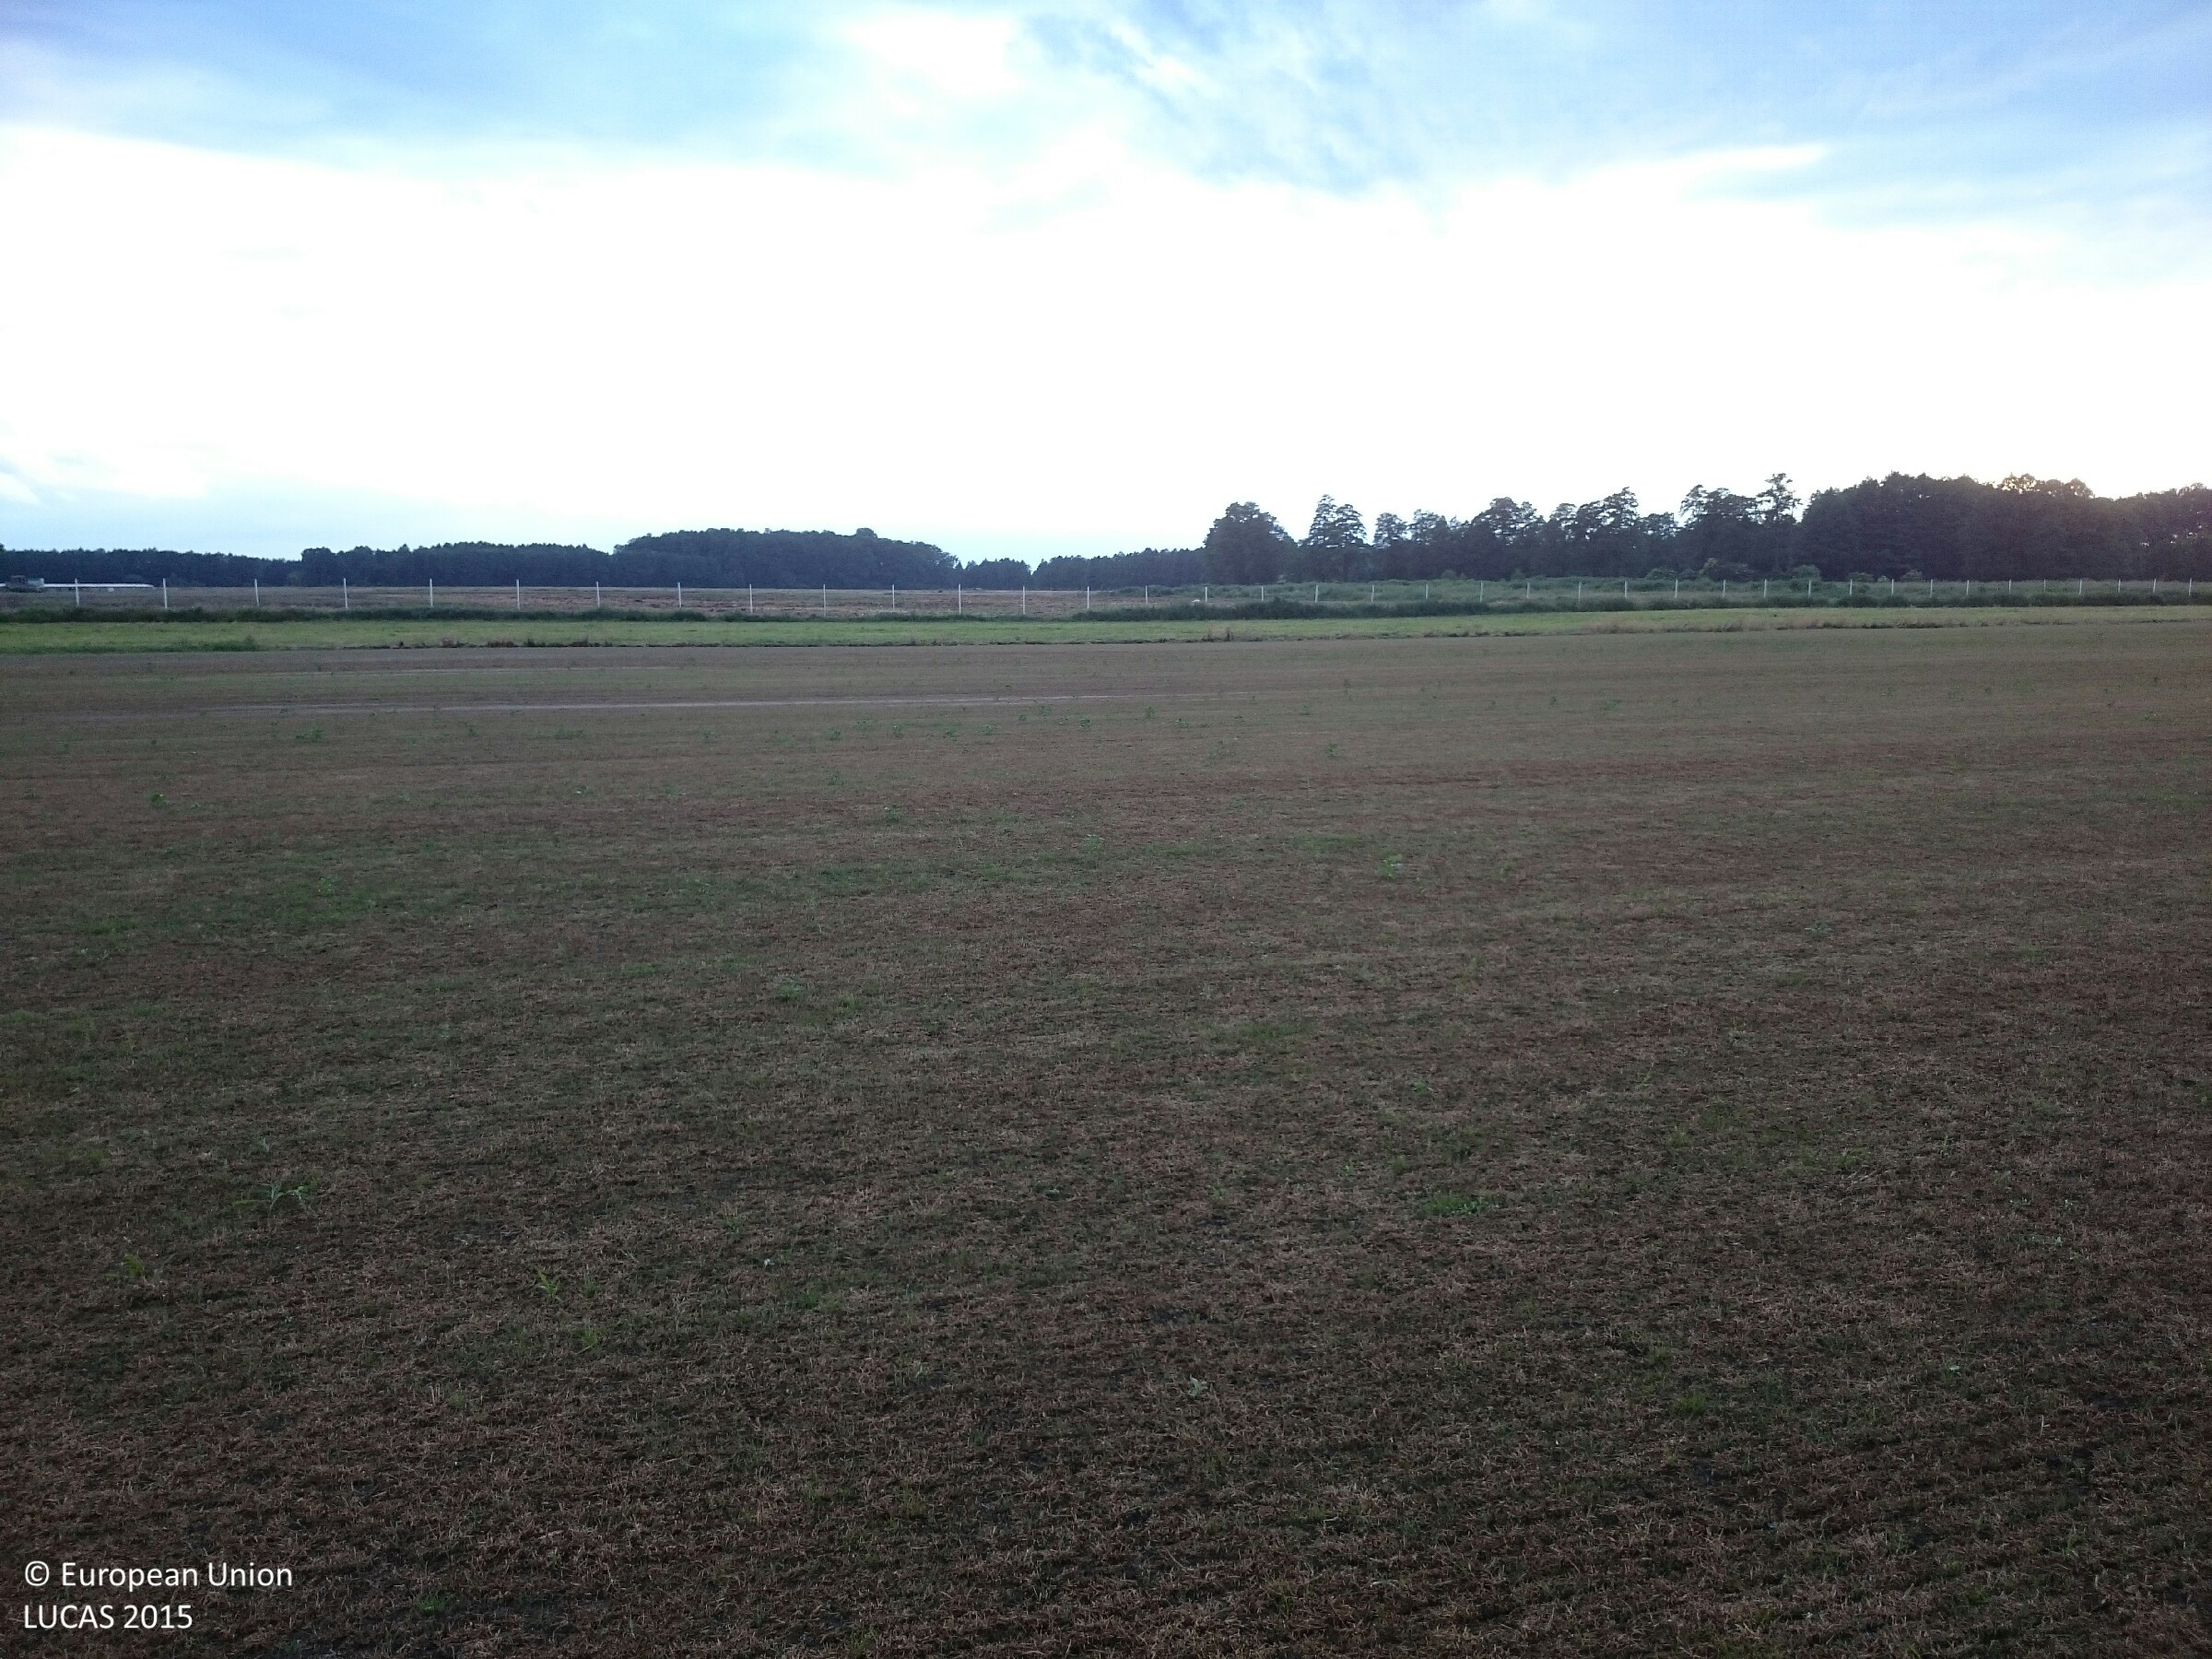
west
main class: Grassland
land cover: Grassland without tree/shrub cover
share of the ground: > 75 %
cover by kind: herbaceous plants 100 %
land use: Agriculture (excluding fallow land and kitchen gardens)
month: June
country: PL
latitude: 52.7476
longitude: 15.6485
